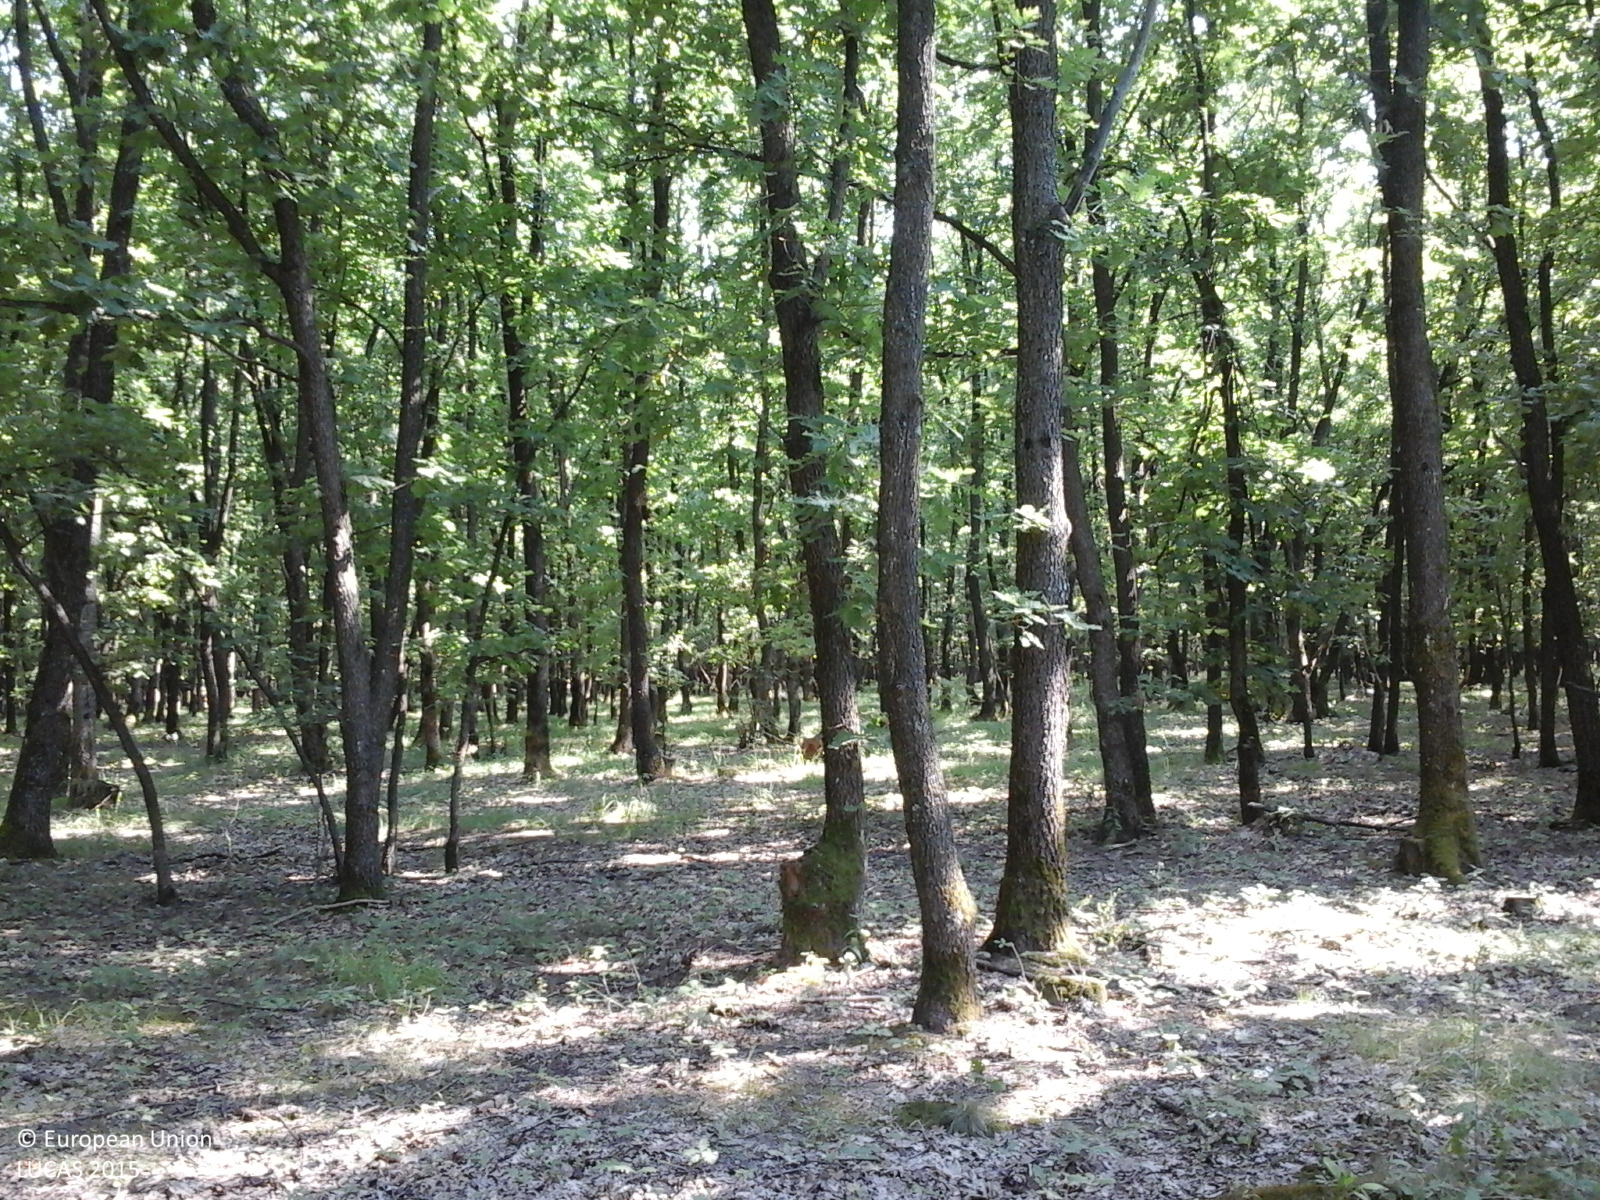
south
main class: Woodland
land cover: Broadleaved woodland
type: acidophilous oak and oak-birch forest
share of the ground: > 75 %
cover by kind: broadleaved forest trees 100 %
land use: Forestry
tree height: > 5 m
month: July
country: RO
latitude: 44.7022
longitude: 24.6012
